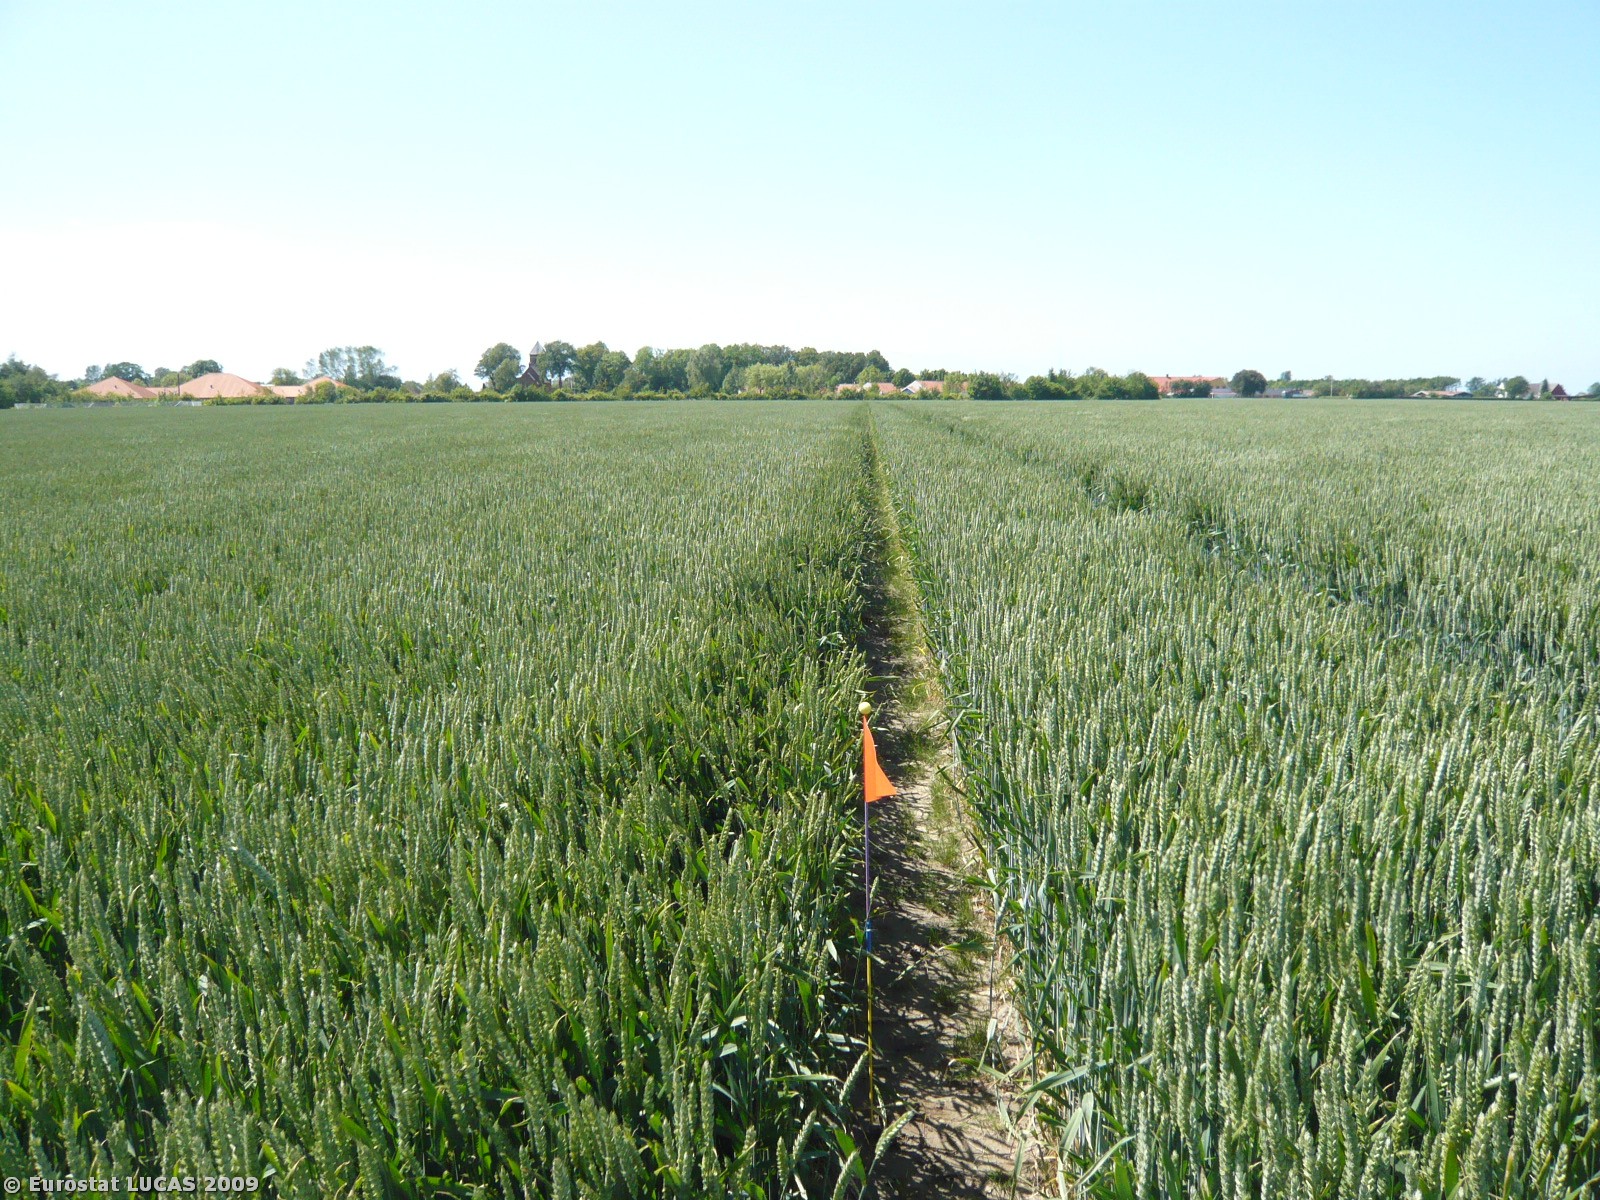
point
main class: Cropland
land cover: Common wheat
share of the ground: > 75 %
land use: Agriculture (excluding fallow land and kitchen gardens)
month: June
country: DK
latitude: 54.7621
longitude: 11.1958
